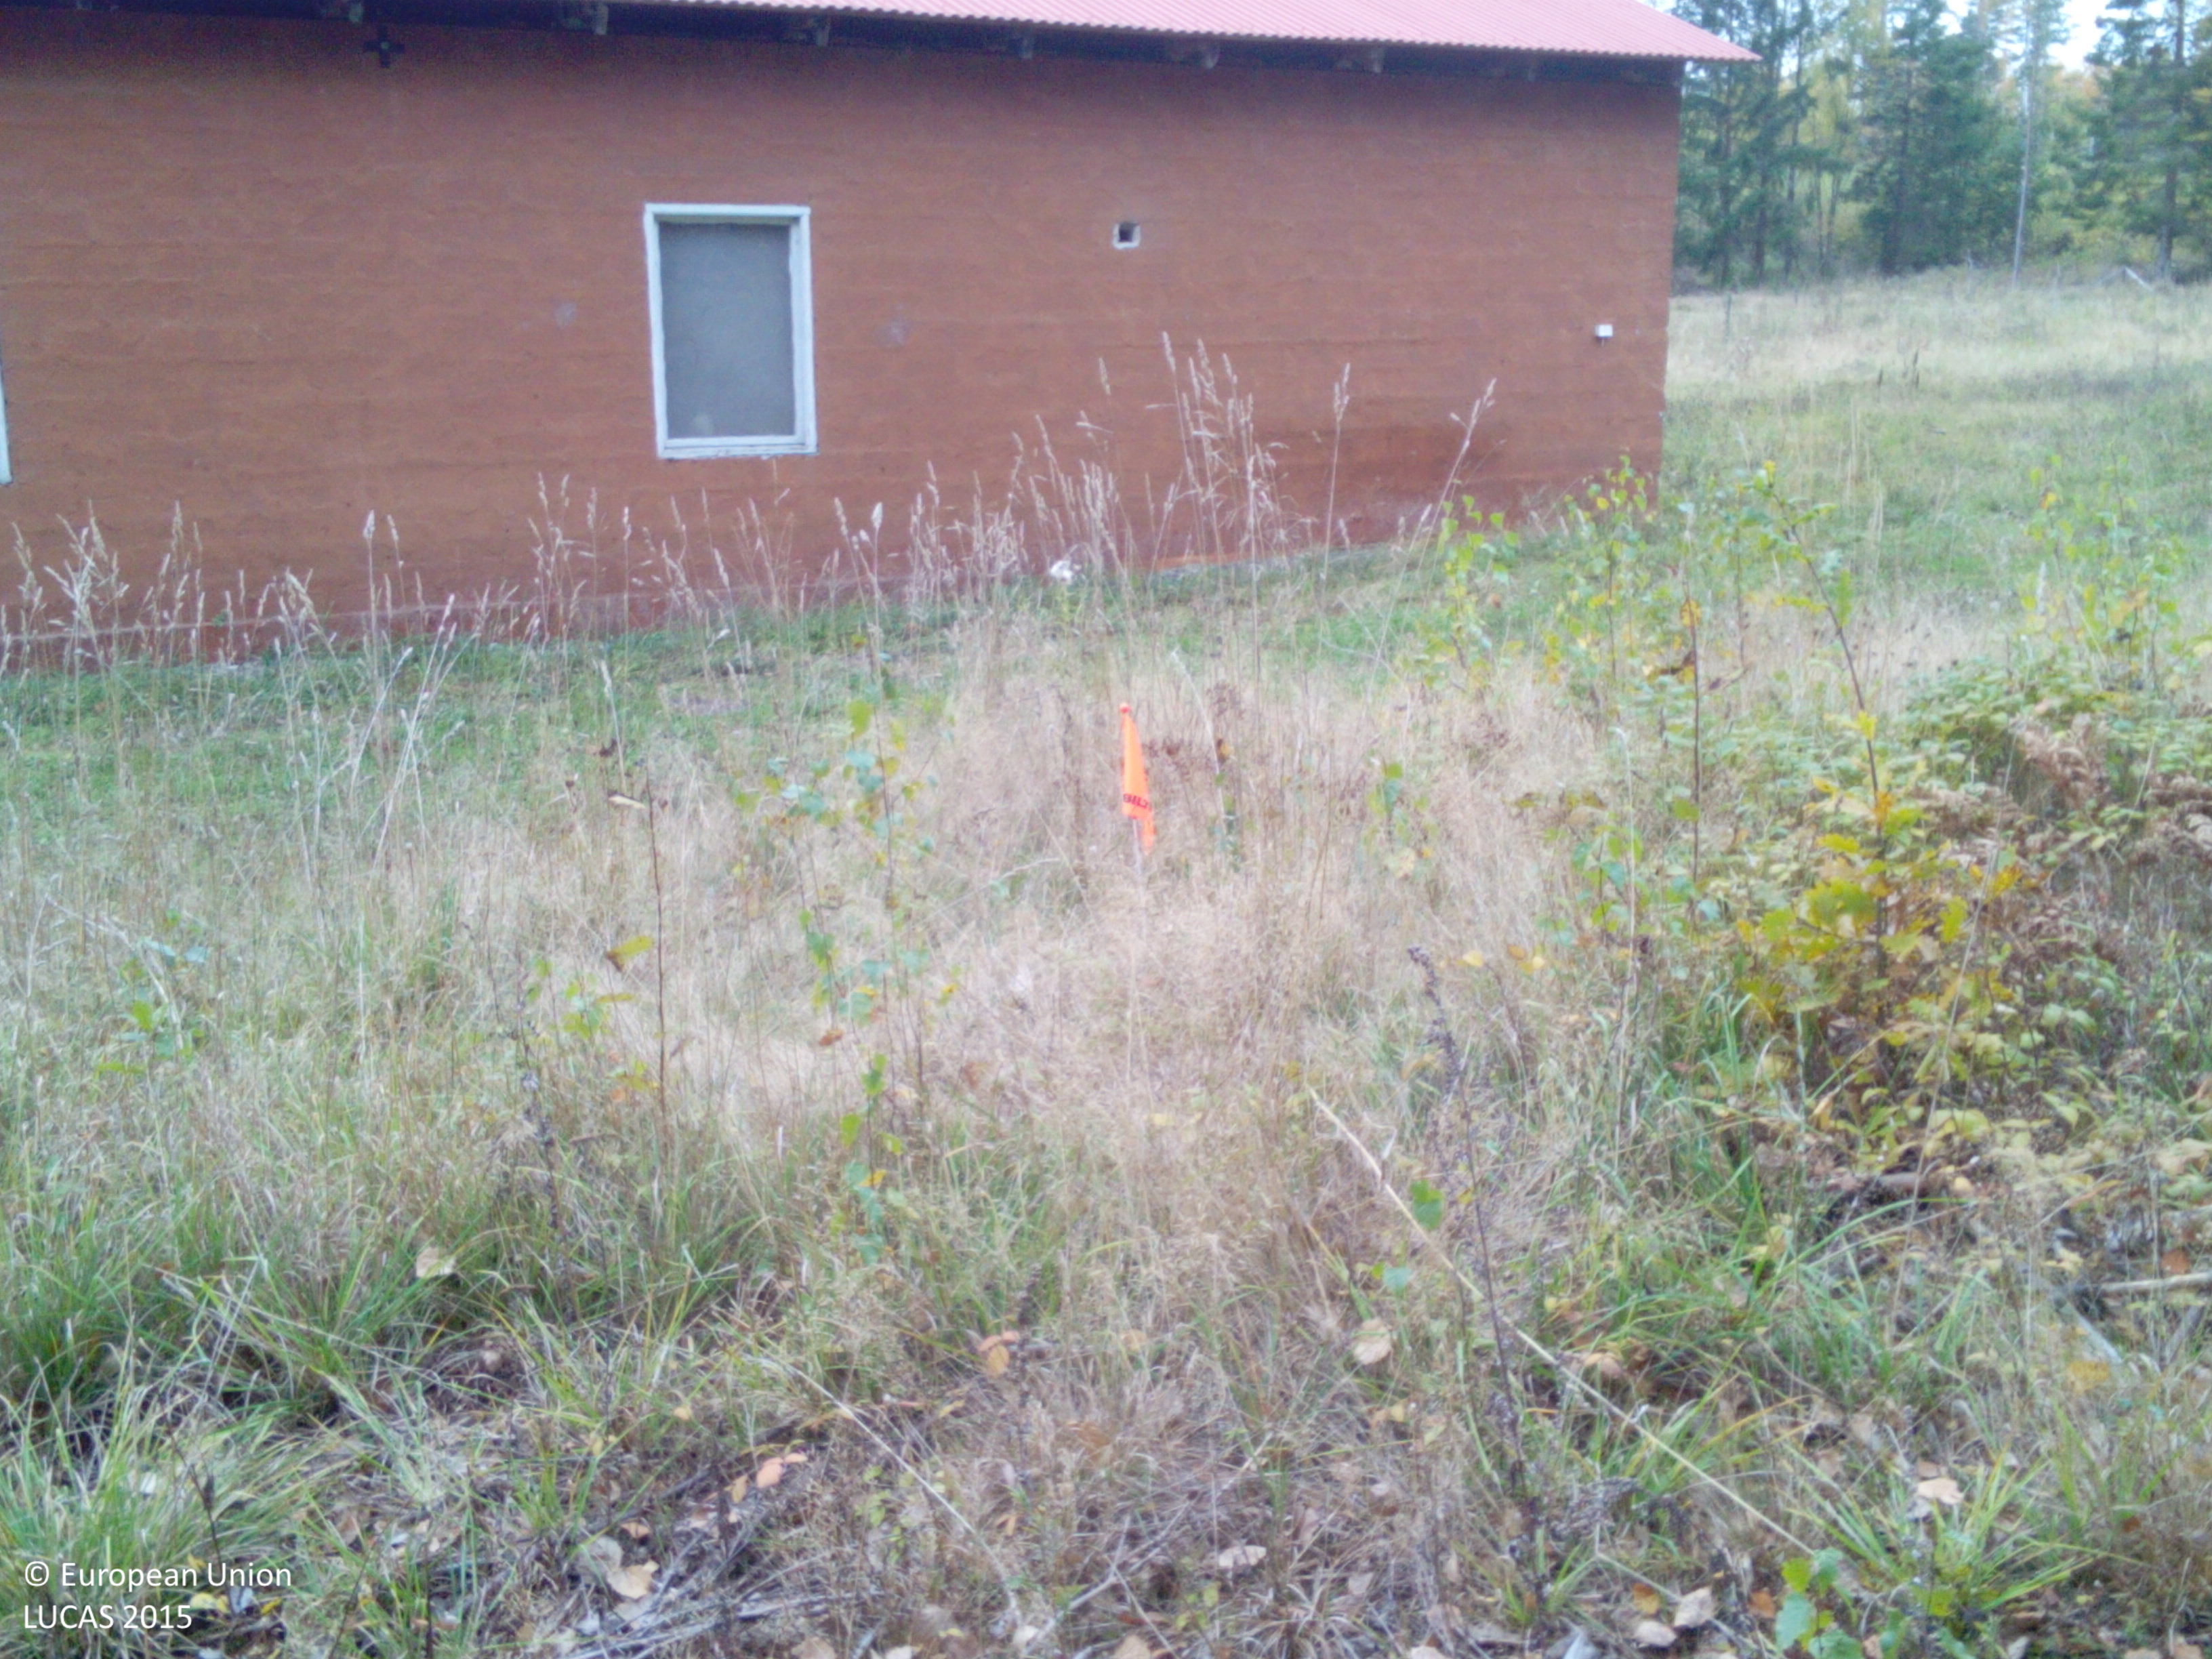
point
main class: Shrubland
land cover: Shrubland with sparse tree cover
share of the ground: 25 - 50 %
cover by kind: shrubs 45 %, herbaceous plants 40 %, broadleaved forest trees 5 %
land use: Semi-natural and natural areas not in use
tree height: < 5 m
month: October
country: SE
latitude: 58.8569
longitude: 16.4957
